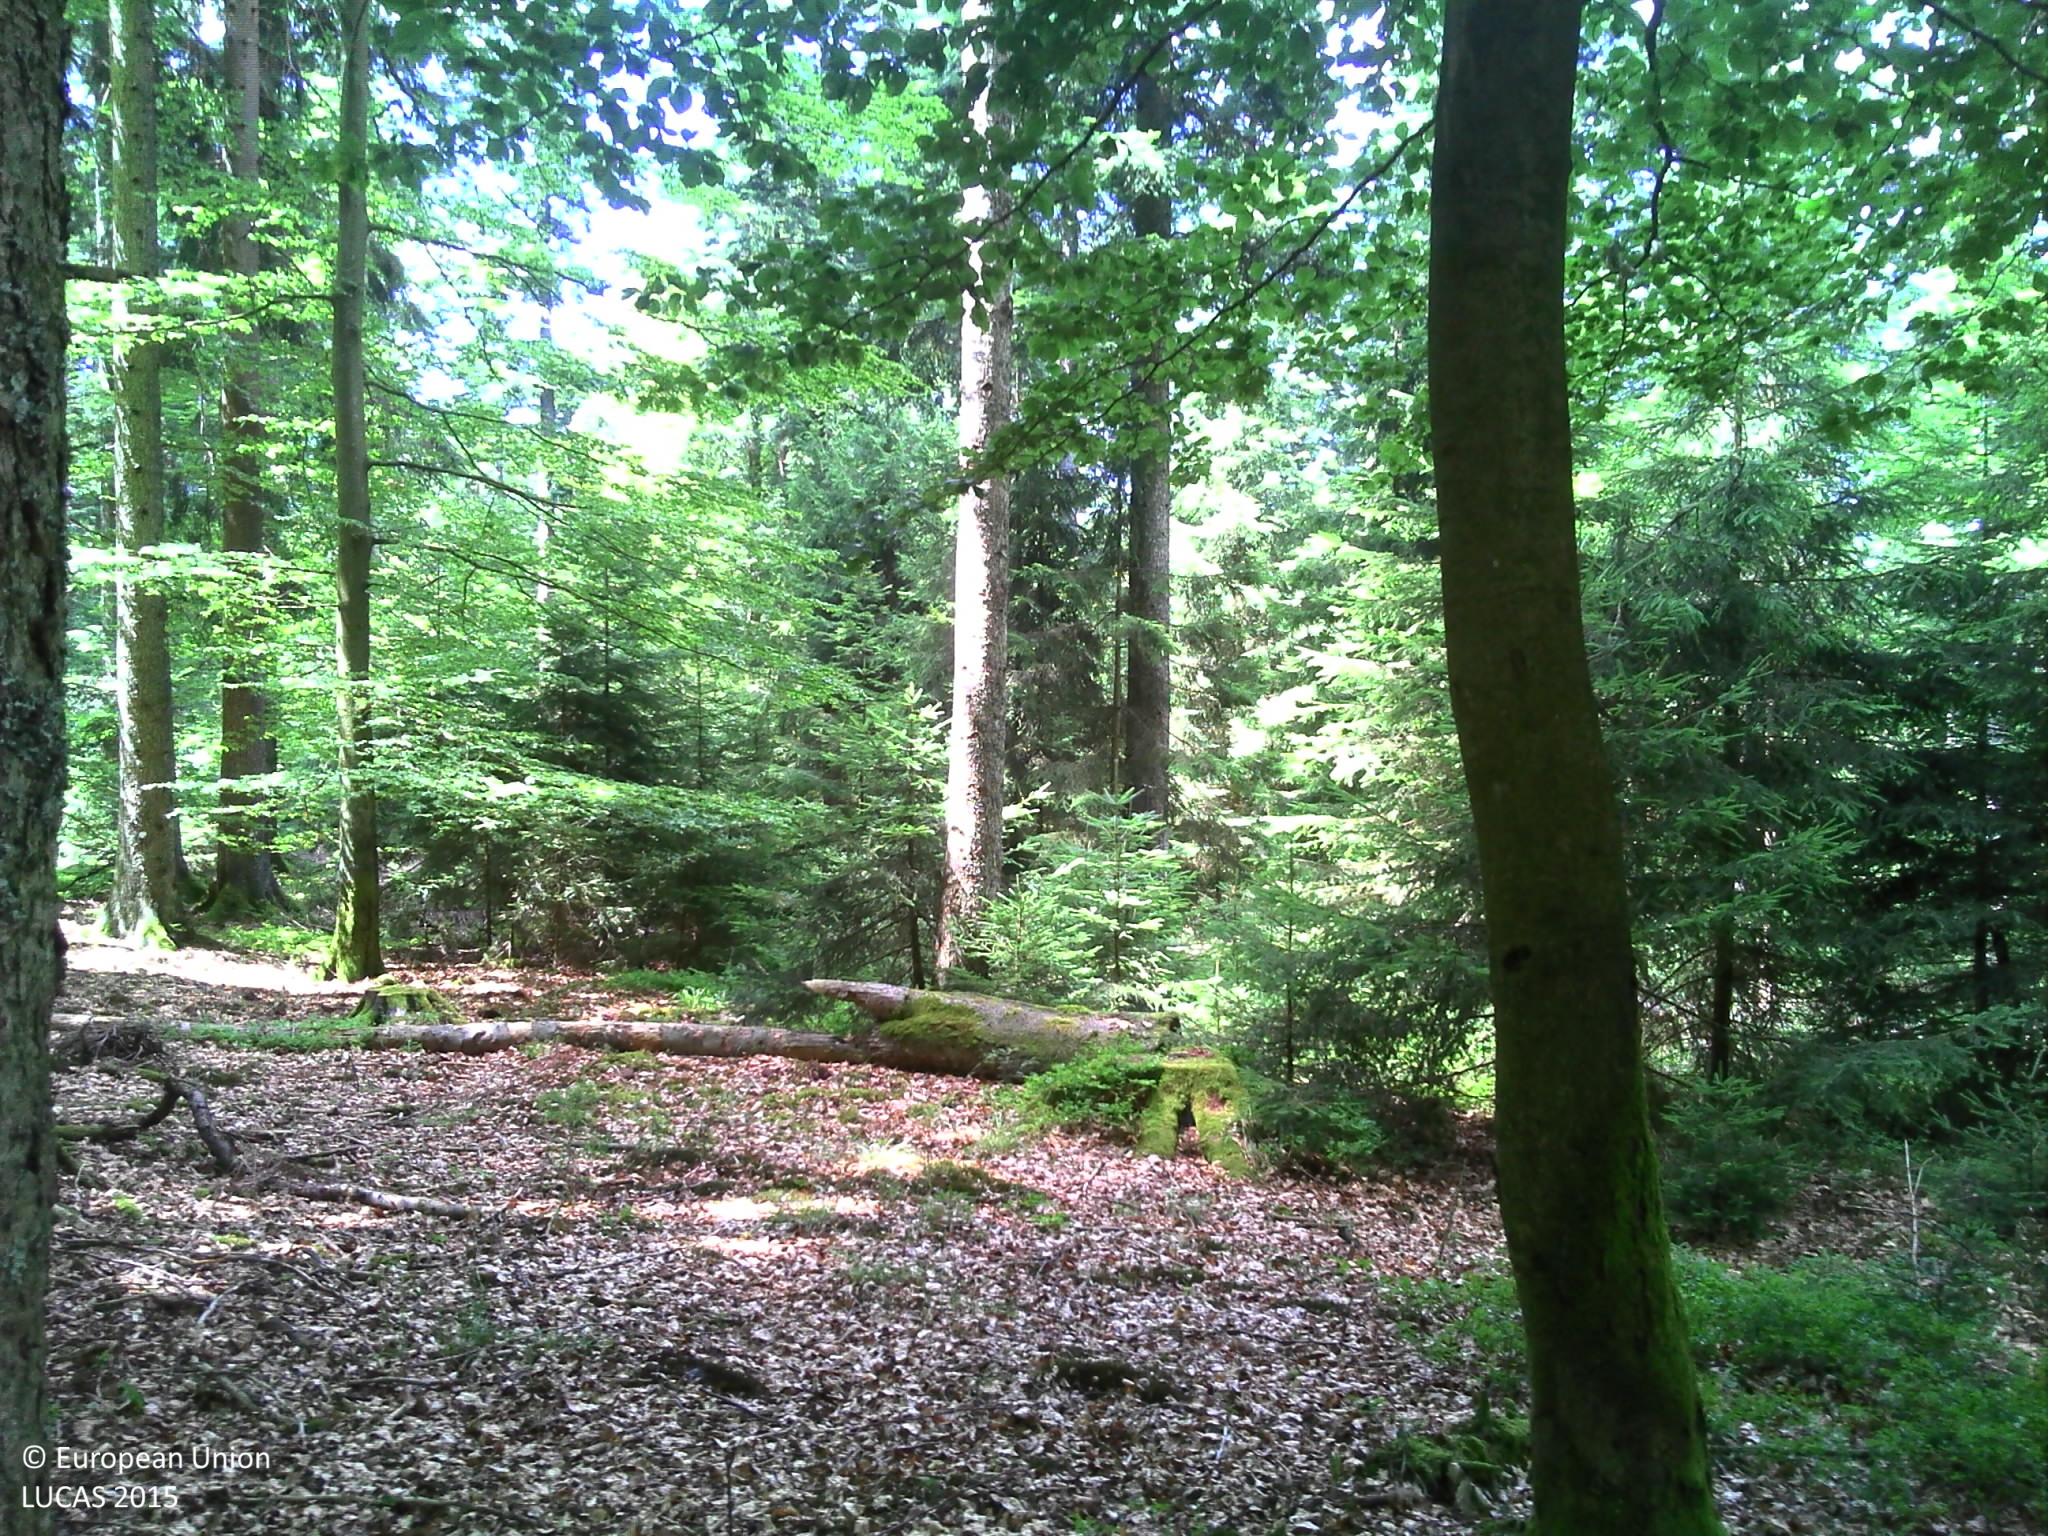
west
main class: Woodland
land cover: Spruce dominated mixed woodland
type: mountainous beech forest
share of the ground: > 75 %
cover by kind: broadleaved forest trees 60 %, coniferous forest trees 40 %
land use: Forestry
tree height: > 5 m
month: July
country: FR
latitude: 48.5873
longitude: 7.3300
